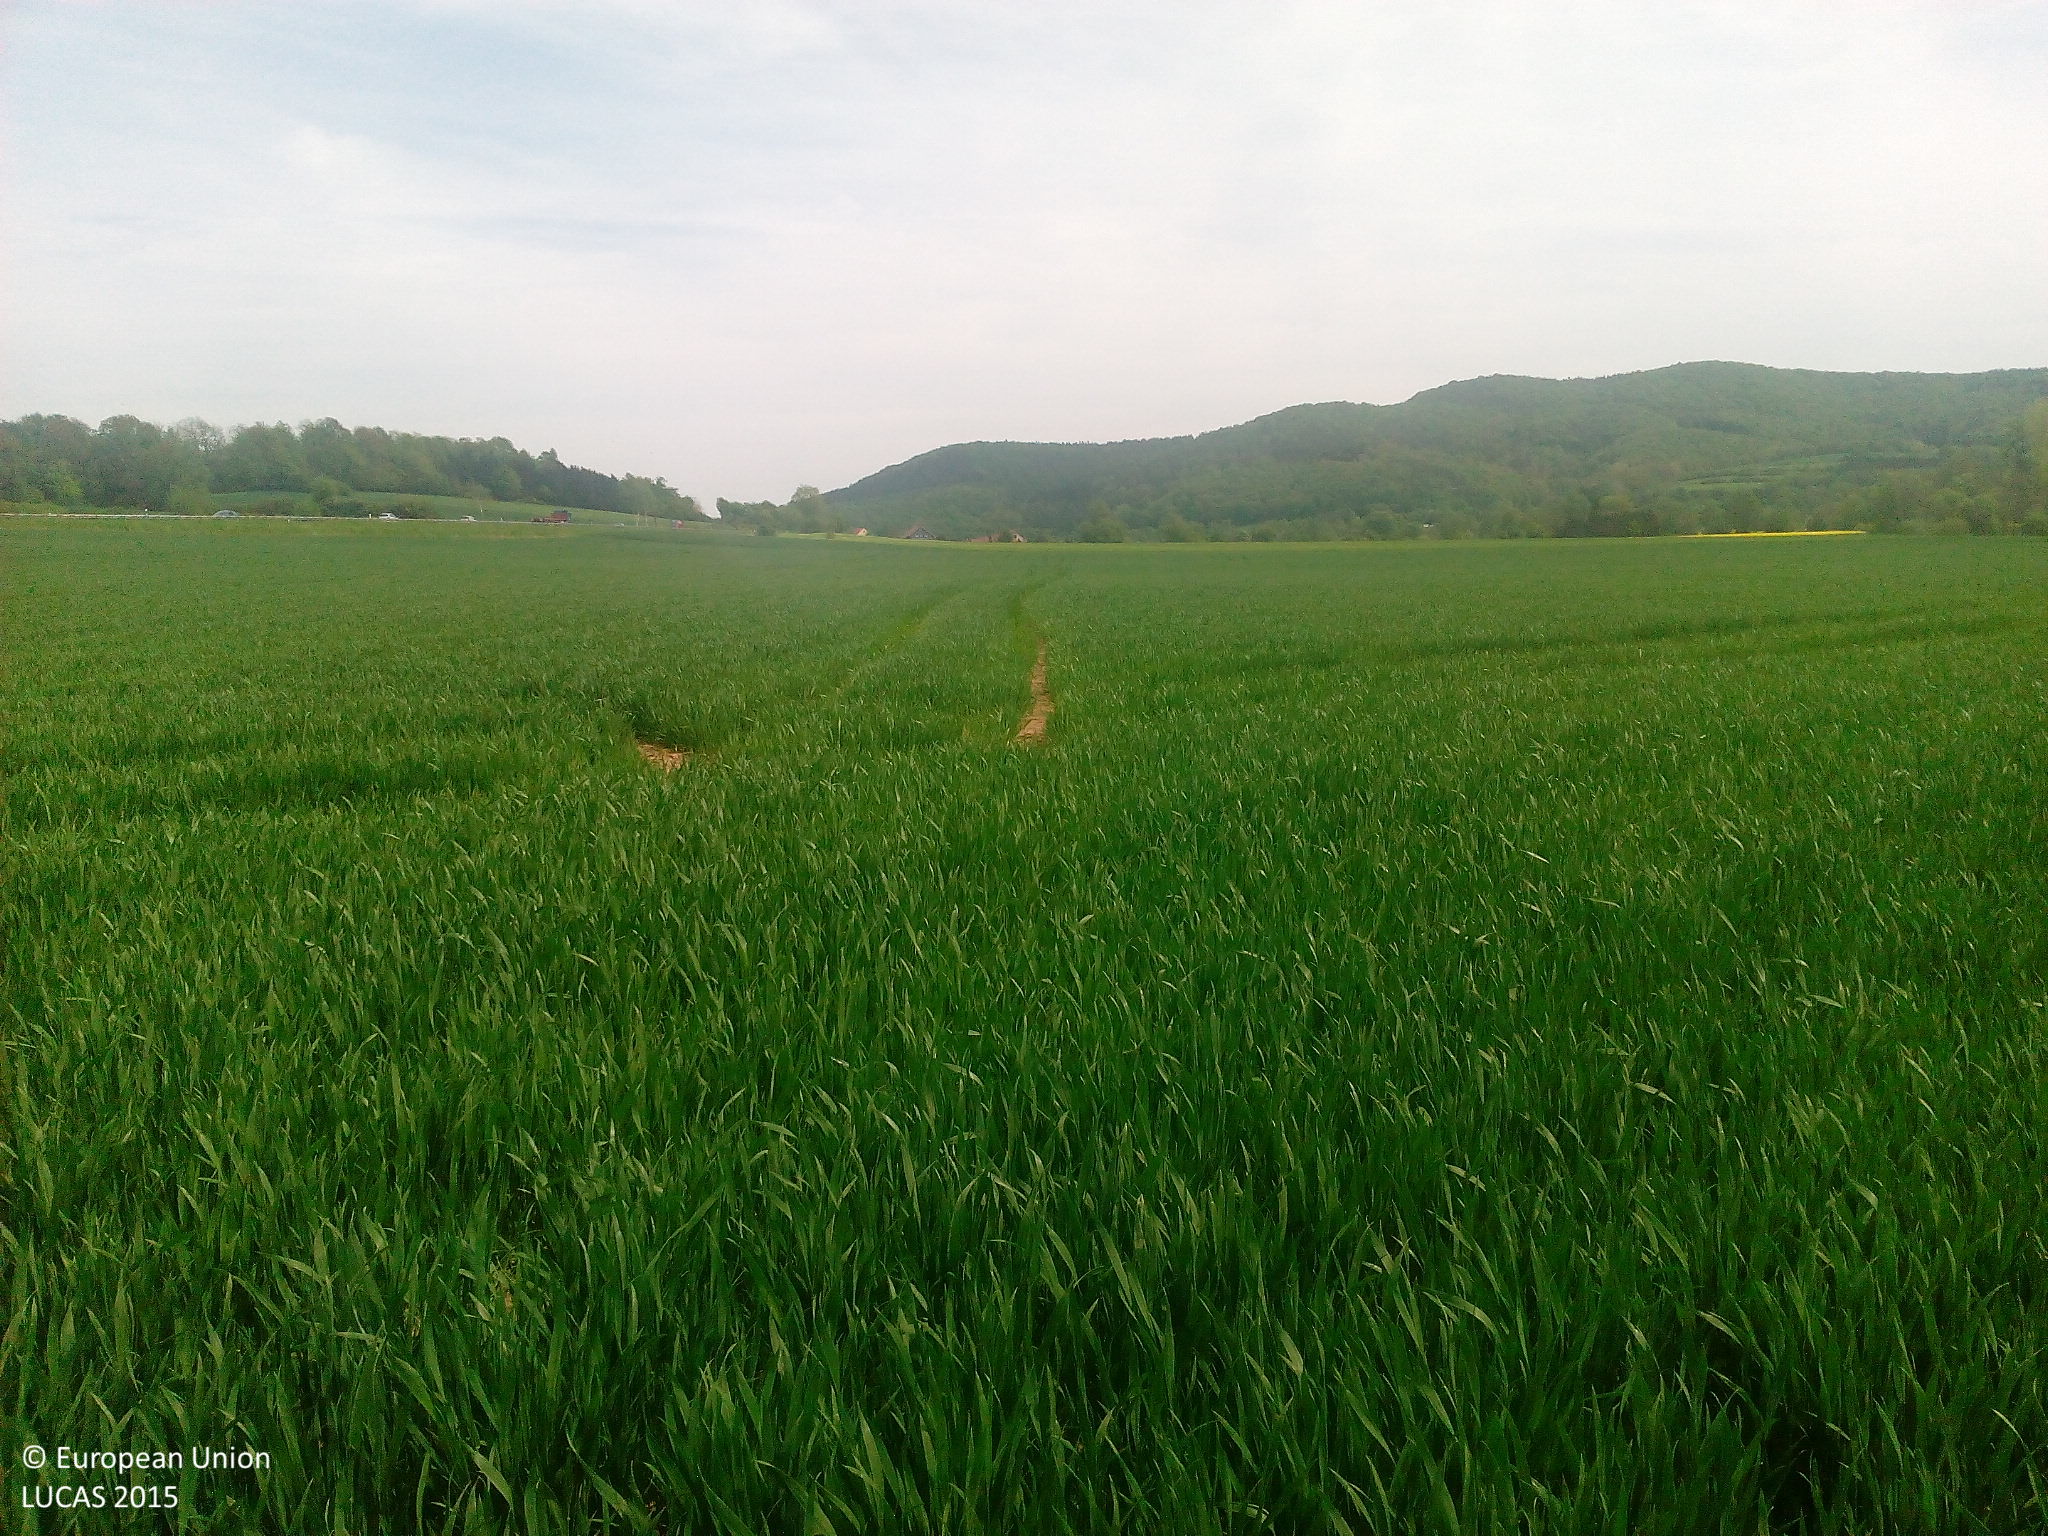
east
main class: Cropland
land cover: Common wheat
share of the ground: > 75 %
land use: Agriculture (excluding fallow land and kitchen gardens)
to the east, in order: Common wheat
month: May
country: DE
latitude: 51.1371
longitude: 9.9571
